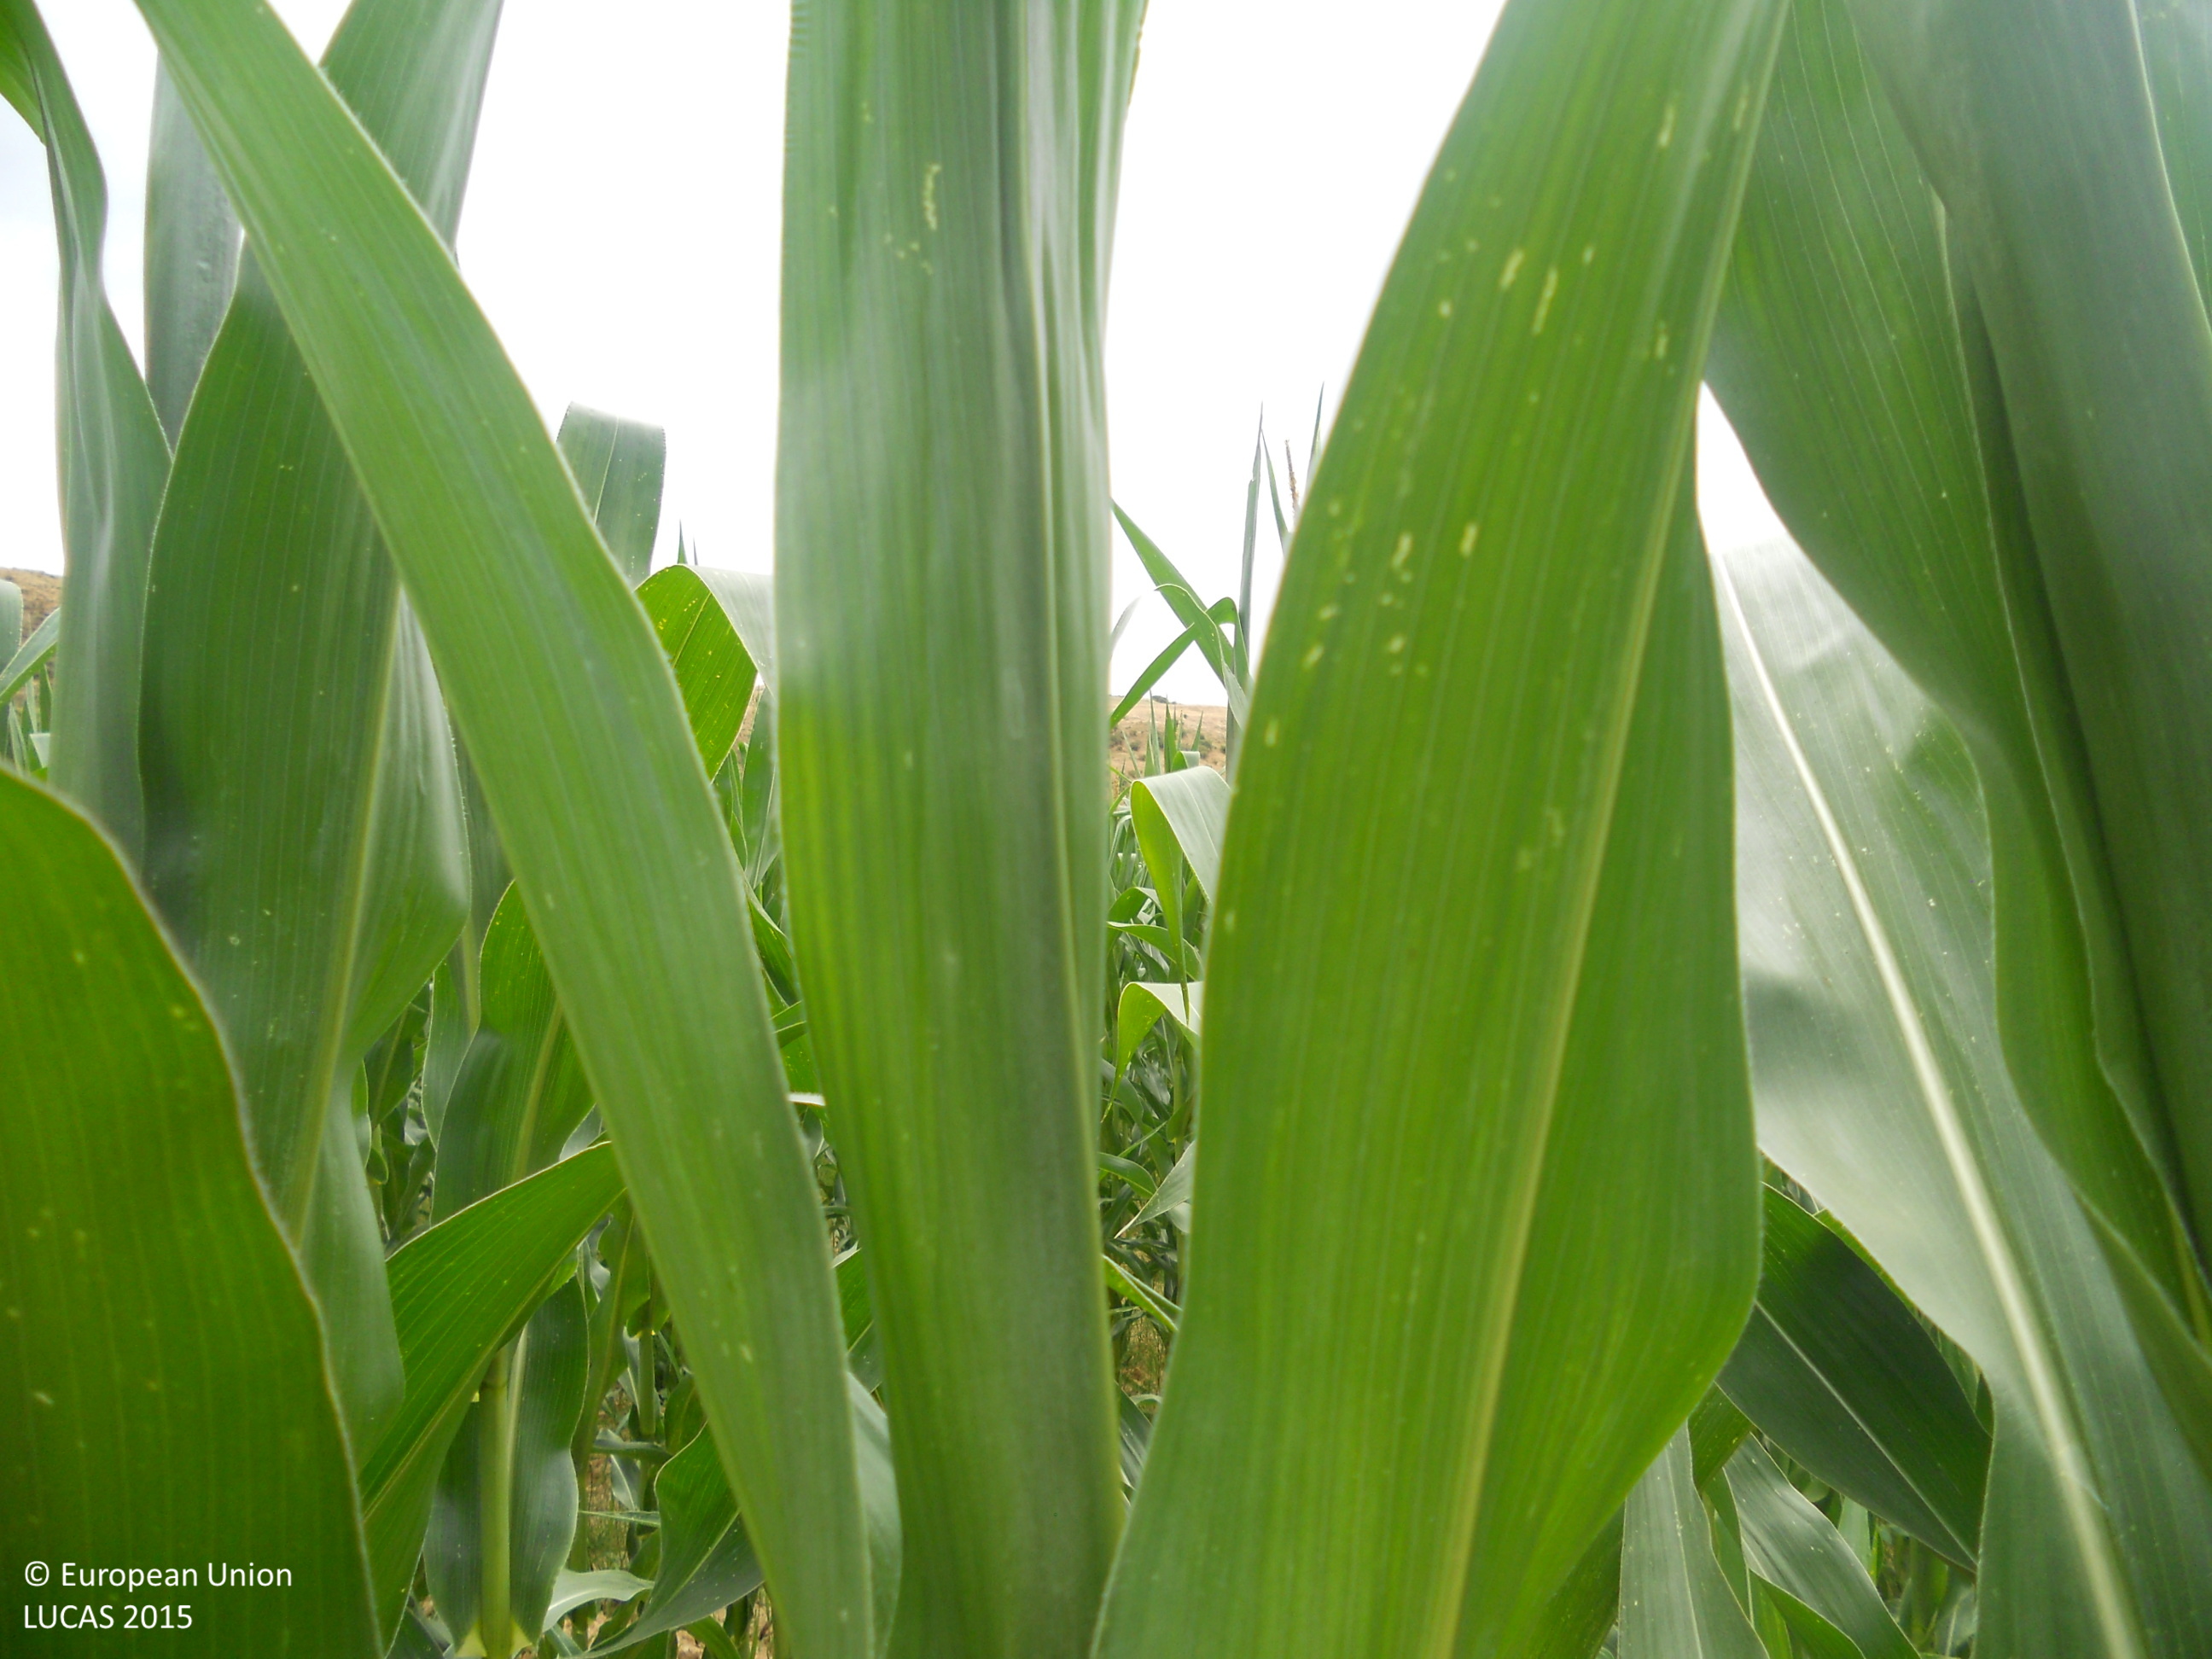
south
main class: Cropland
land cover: Maize
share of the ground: > 75 %
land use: Agriculture (excluding fallow land and kitchen gardens)
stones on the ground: < 10 %
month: July
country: ES
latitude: 42.5469
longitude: -5.4251
